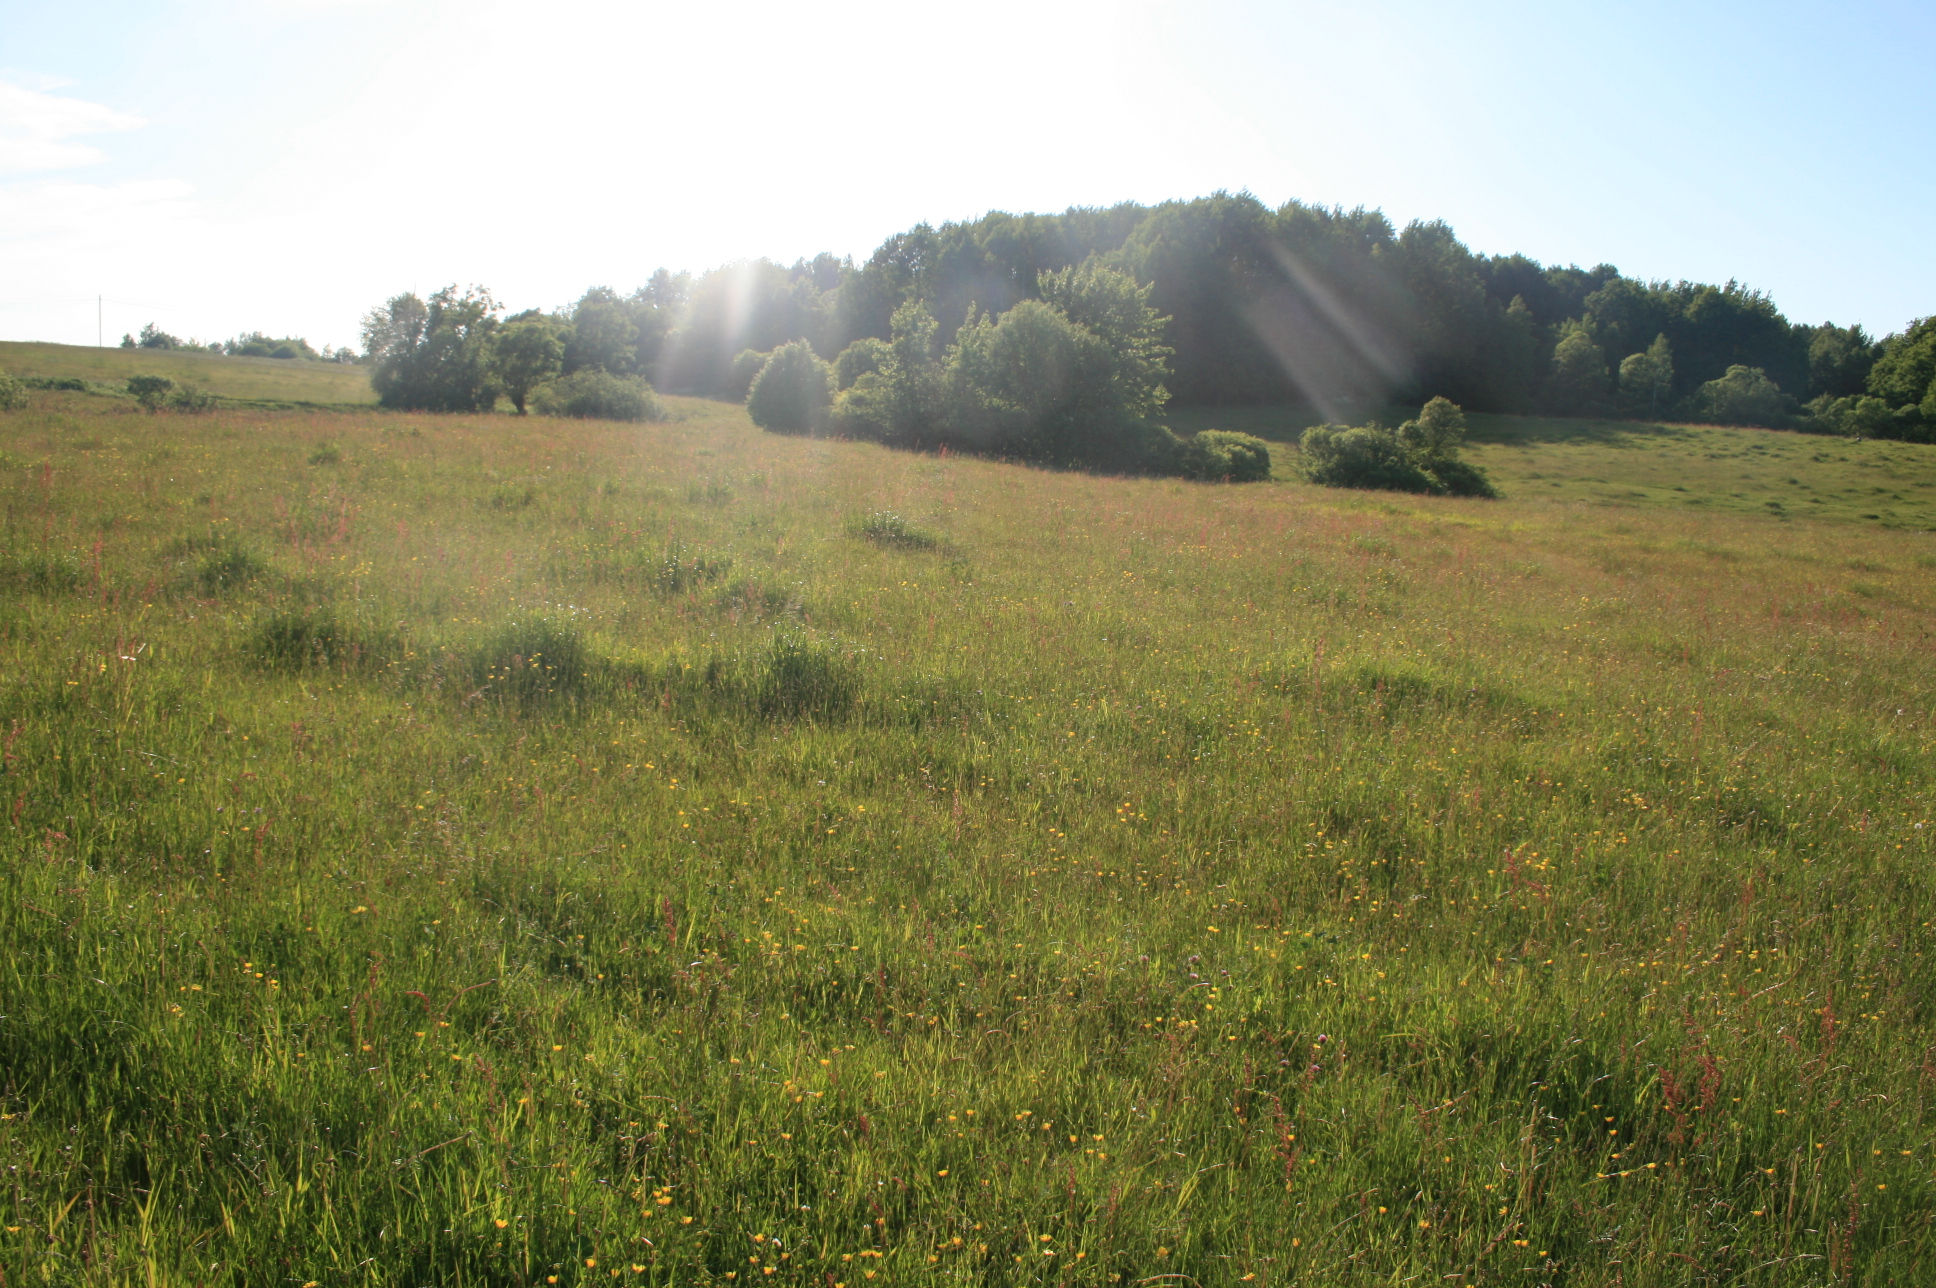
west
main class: Grassland
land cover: Grassland without tree/shrub cover
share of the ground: > 75 %
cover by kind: herbaceous plants 100 %
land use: Agriculture (excluding fallow land and kitchen gardens)
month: June
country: LT
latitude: 55.5617
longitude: 22.2496
